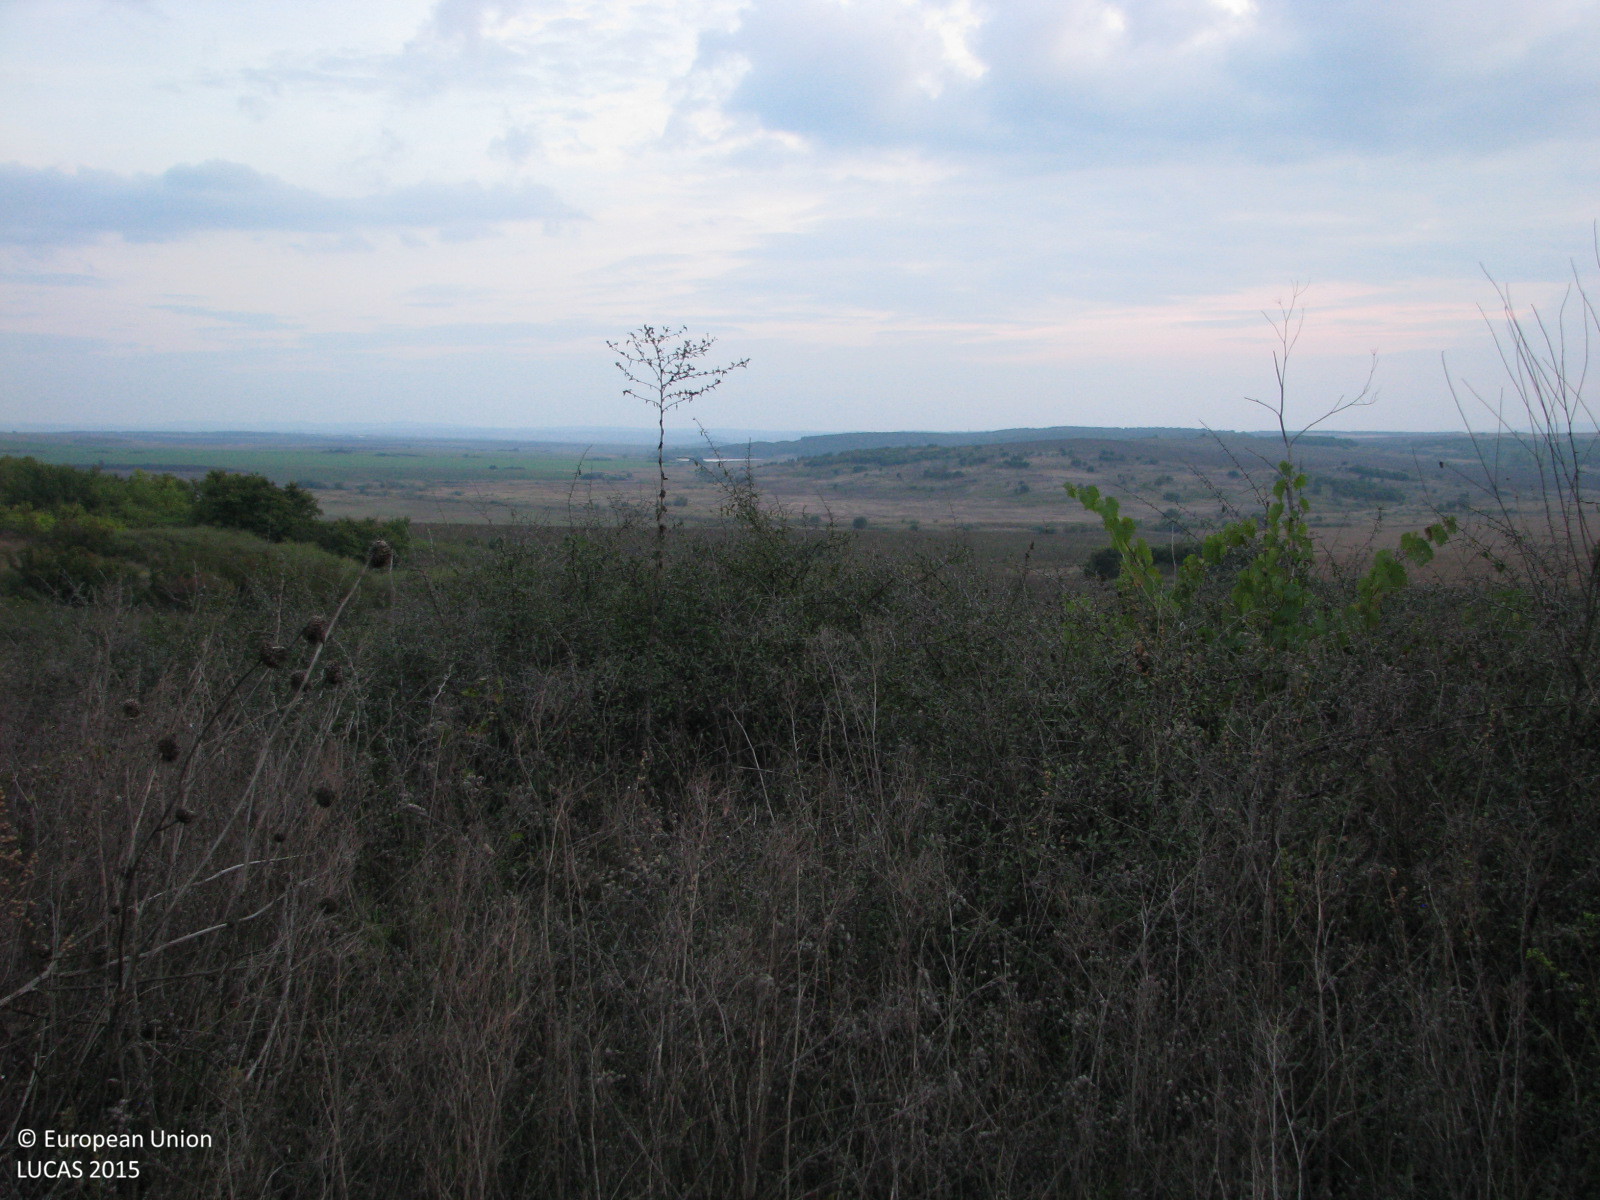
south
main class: Shrubland
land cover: Shrubland with sparse tree cover
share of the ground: 50 - 75 %
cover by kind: shrubs 60 %, herbaceous plants 35 %, broadleaved forest trees 5 %
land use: Semi-natural and natural areas not in use
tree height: < 5 m
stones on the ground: < 10 %
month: October
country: BG
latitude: 42.2524
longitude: 26.4634
